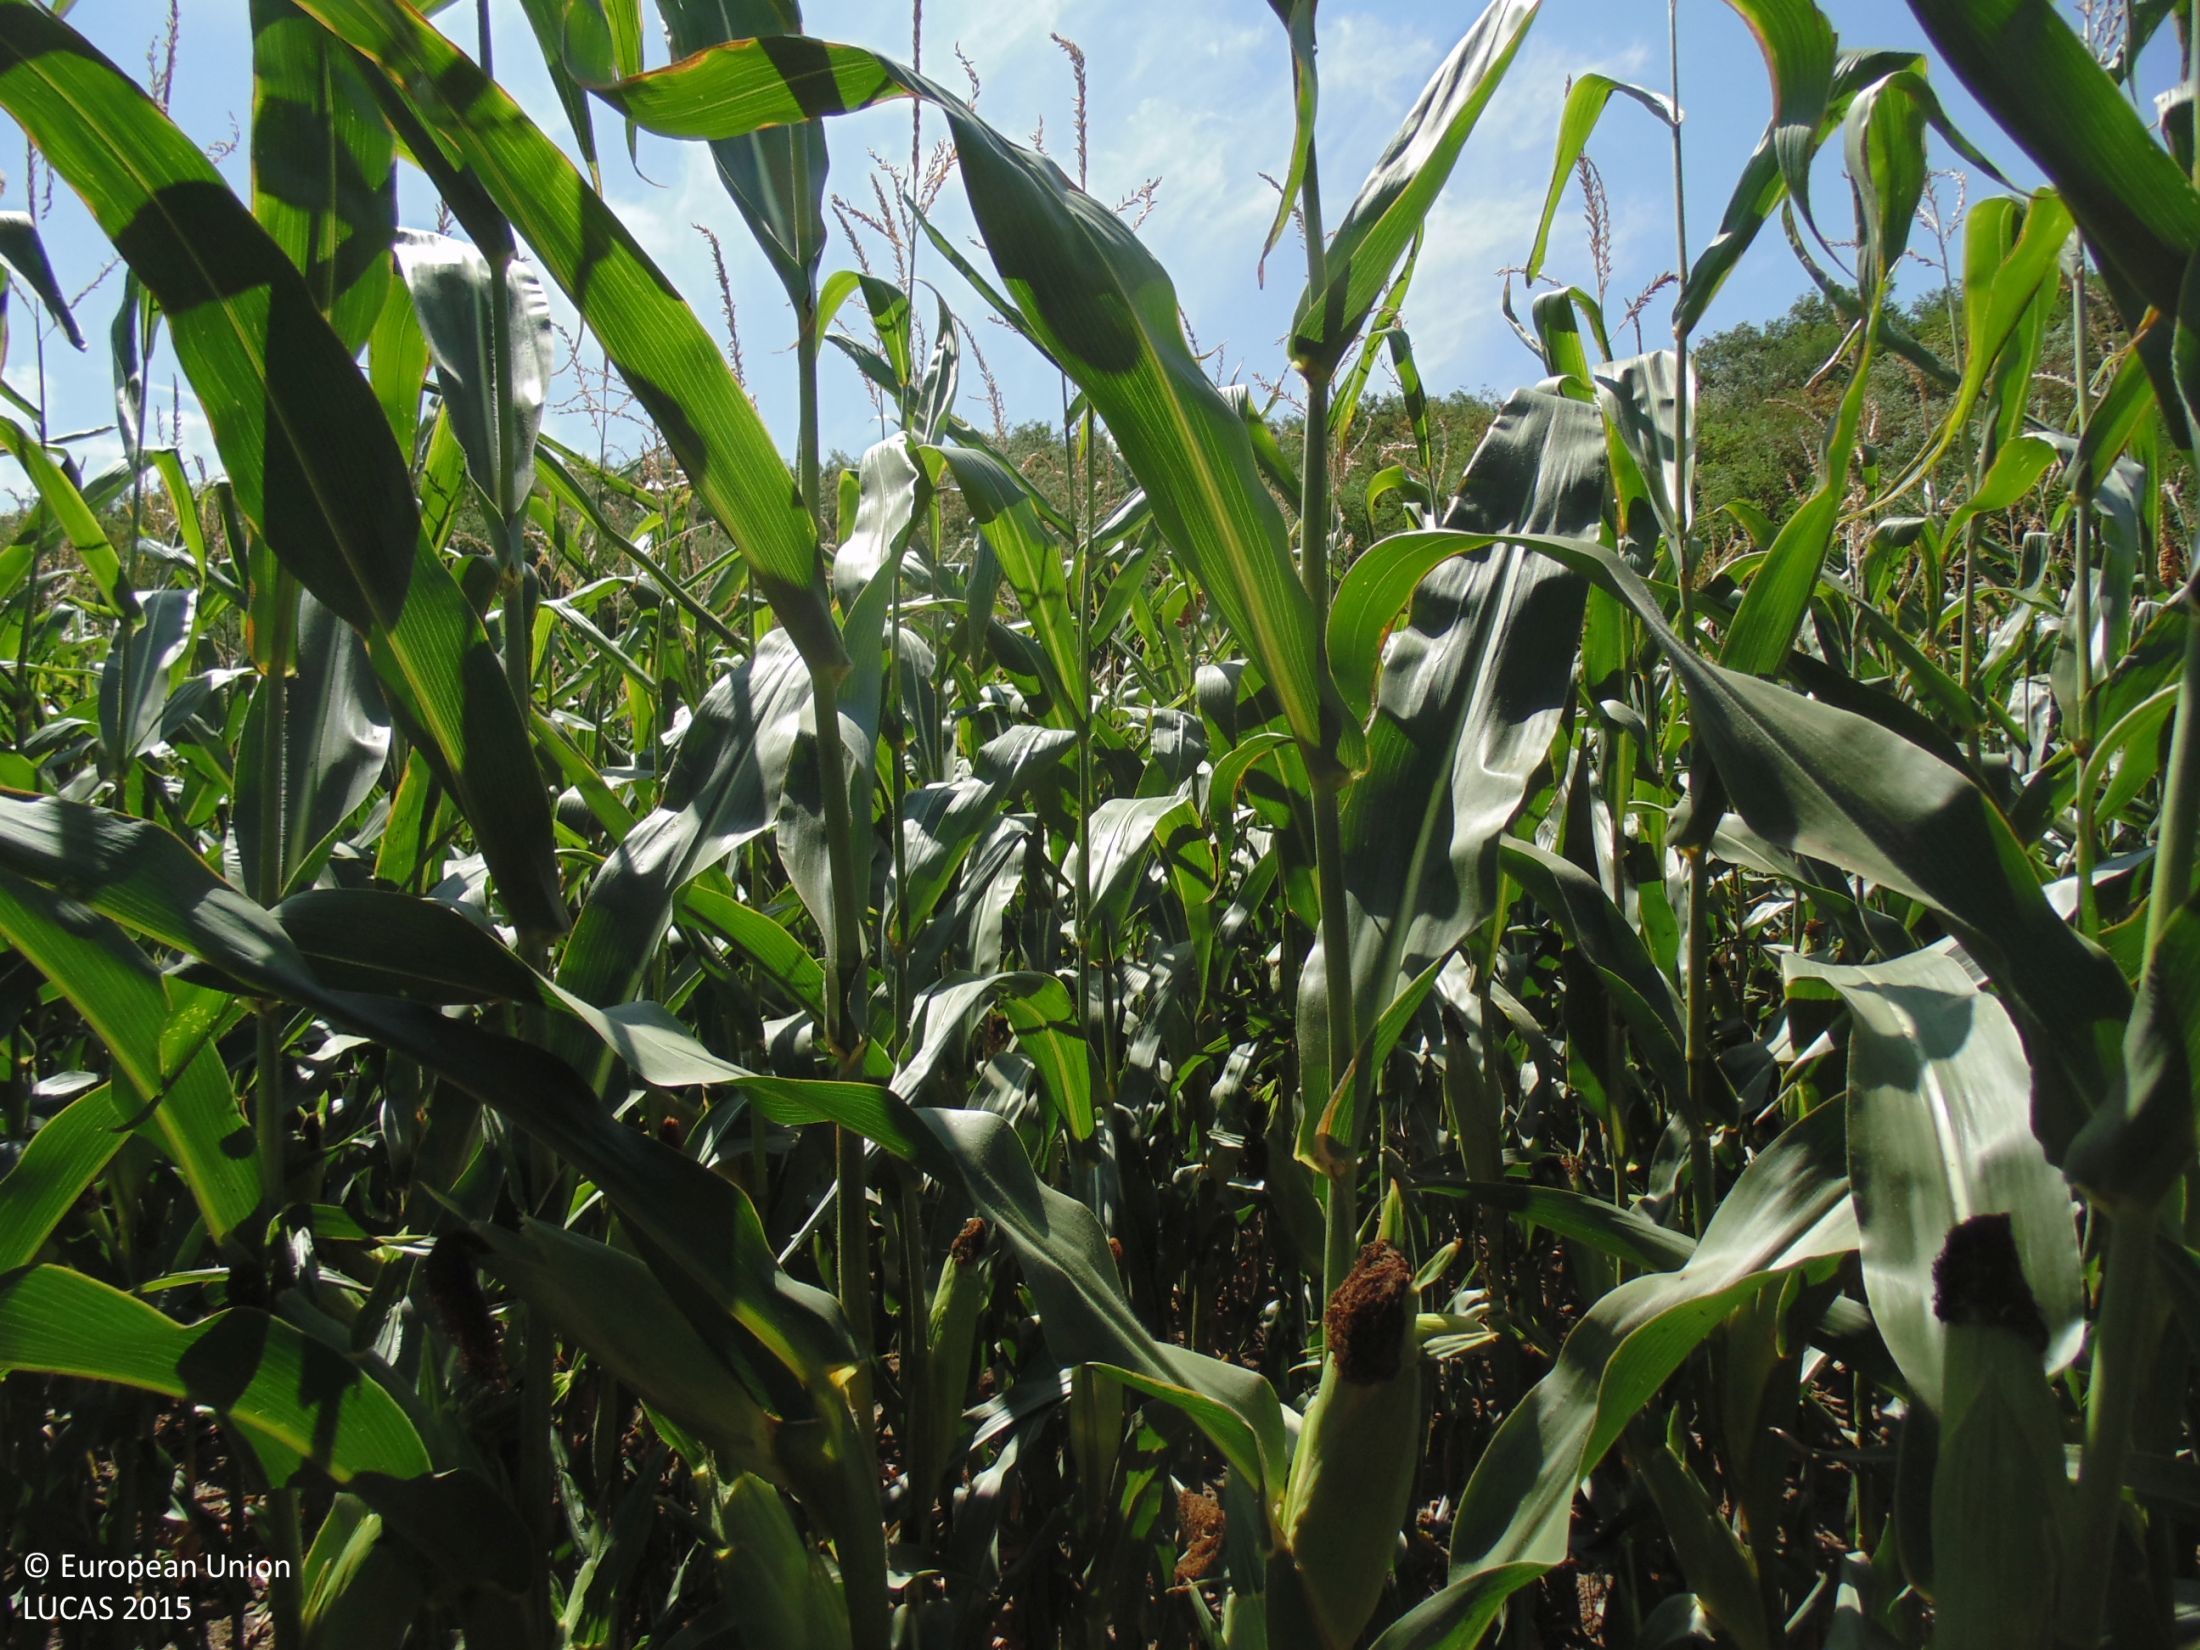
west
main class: Cropland
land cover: Maize
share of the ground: > 75 %
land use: Agriculture (excluding fallow land and kitchen gardens)
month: August
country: BG
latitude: 43.8216
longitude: 27.7355
